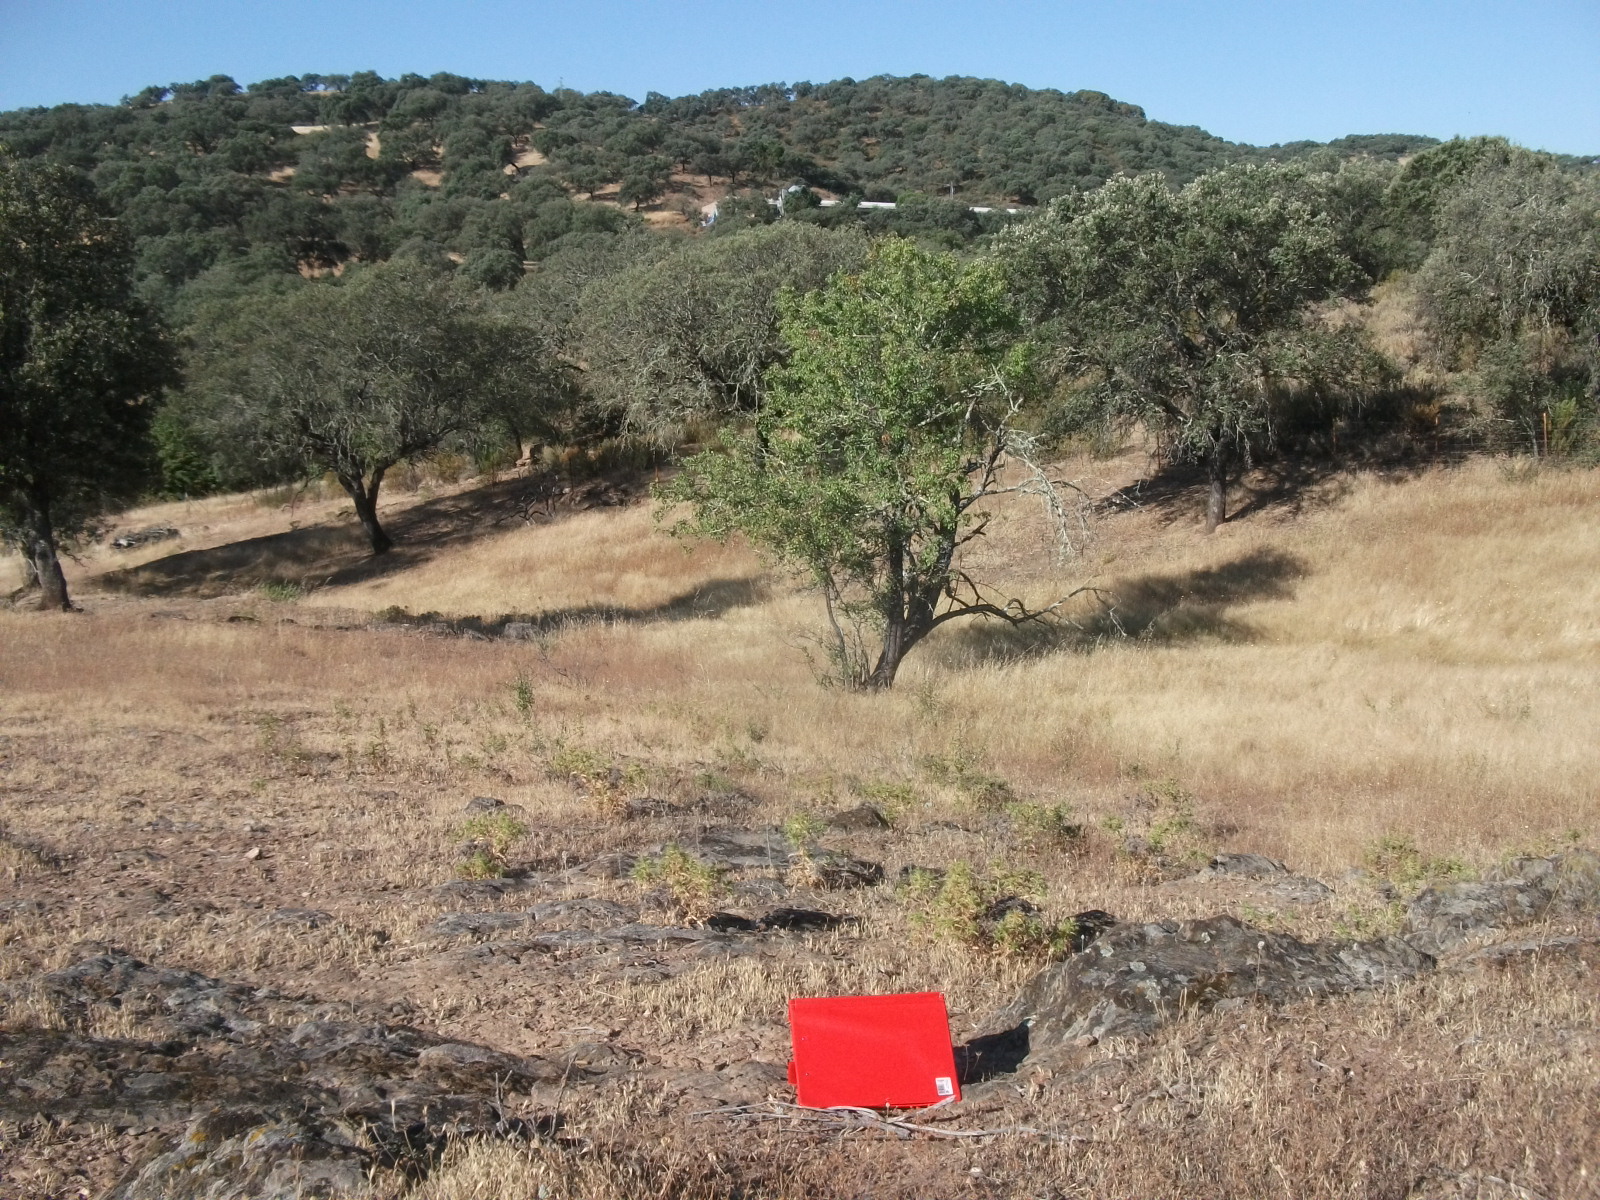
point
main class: Grassland
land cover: Grassland with sparse tree/shrub cover
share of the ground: > 75 %
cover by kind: herbaceous plants 95 %, broadleaved forest trees 5 %
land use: Agriculture (excluding fallow land and kitchen gardens)
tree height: < 5 m
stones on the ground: > 50 %
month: June
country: ES
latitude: 37.6392
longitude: -7.0352
